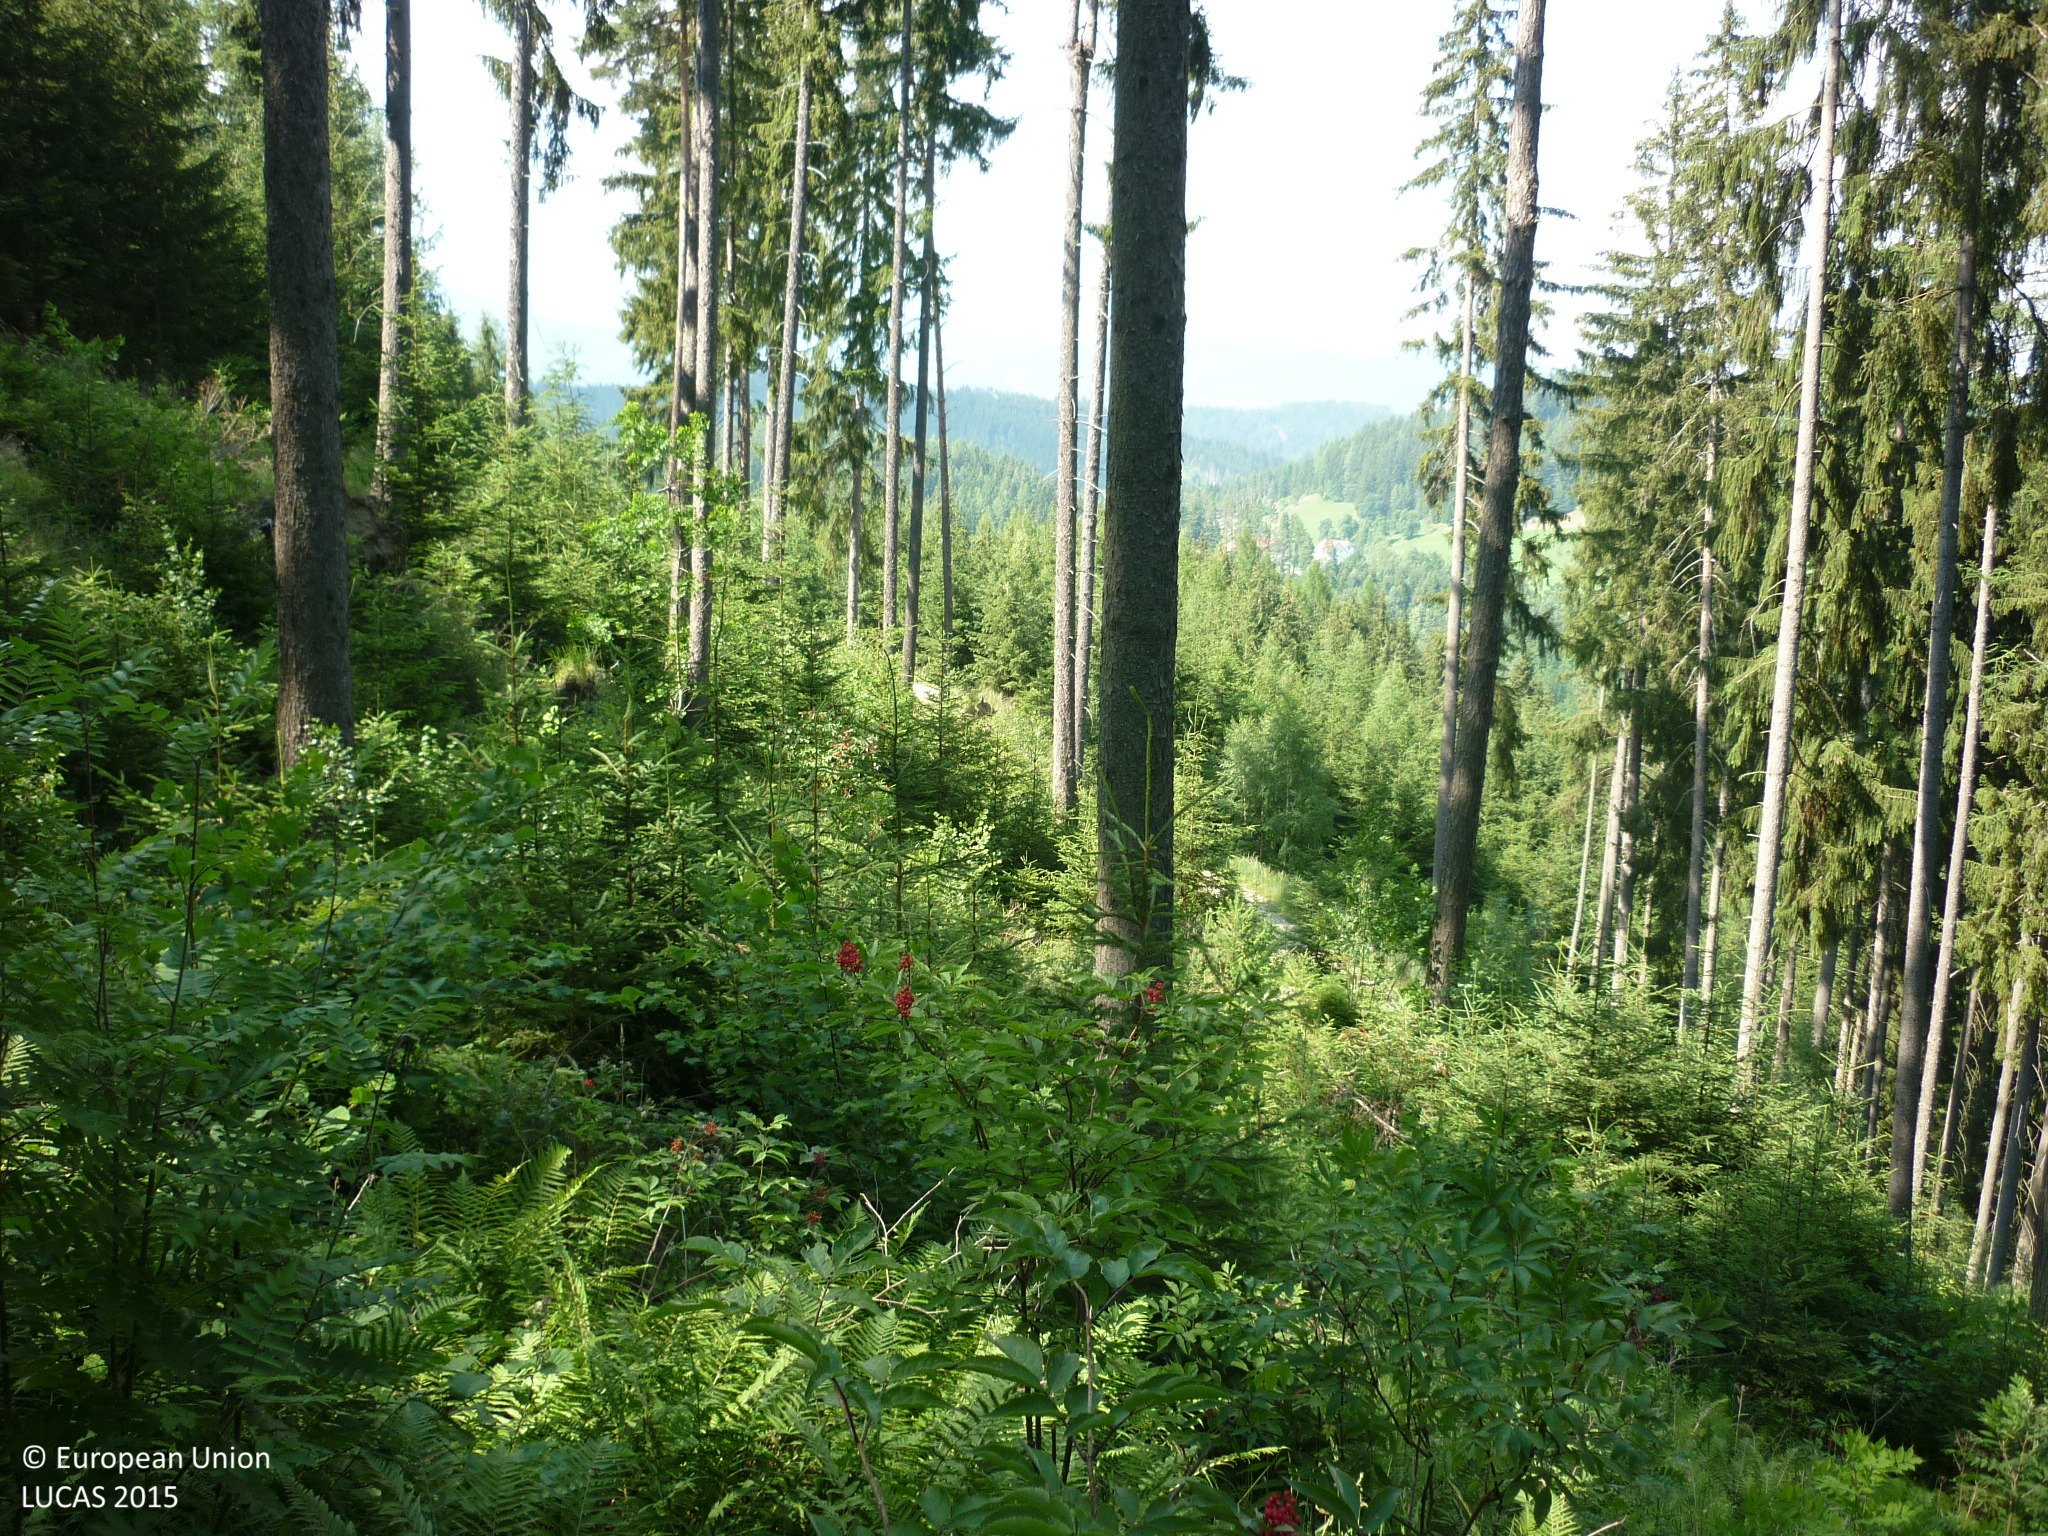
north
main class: Woodland
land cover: Spruce dominated coniferous woodland
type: alpine coniferous forest
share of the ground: 50 - 75 %
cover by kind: coniferous forest trees 40 %, herbaceous plants 30 %, shrubs 20 %, broadleaved forest trees 10 %
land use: Forestry
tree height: > 5 m
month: July
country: AT
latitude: 47.1964
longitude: 14.8697
